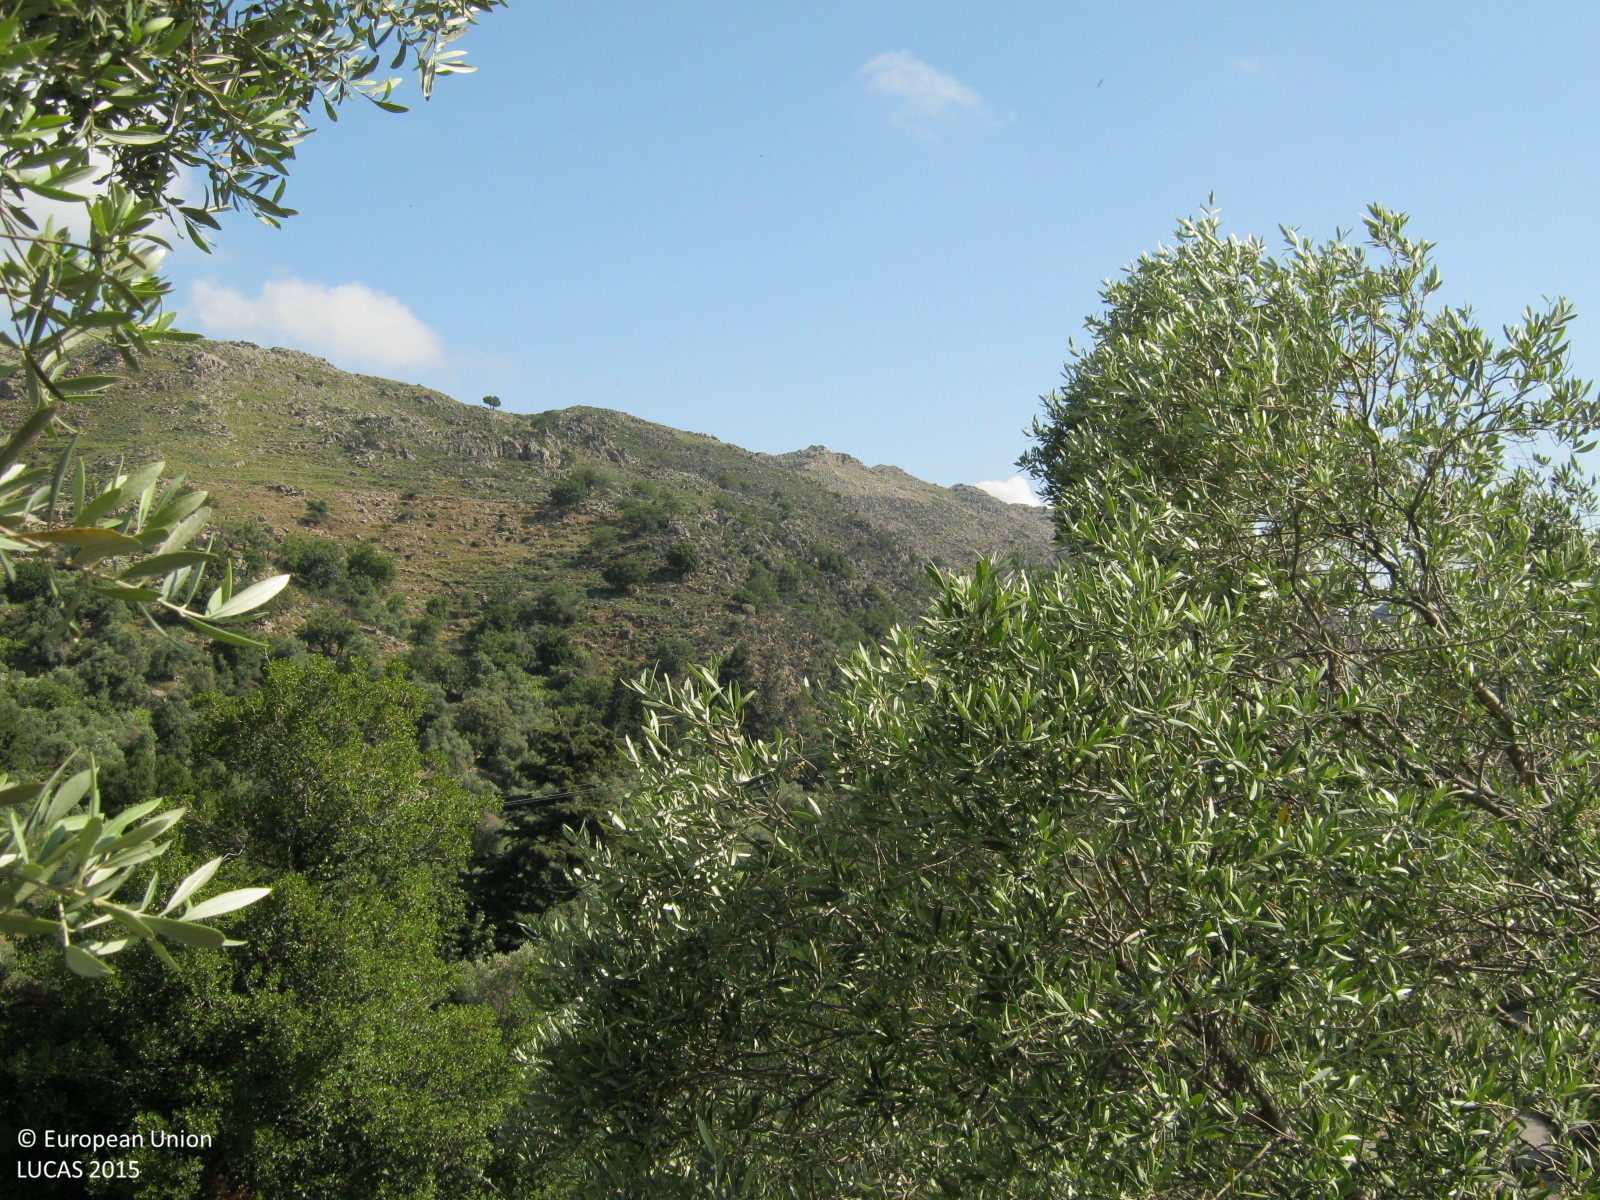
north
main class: Cropland
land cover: Olive groves
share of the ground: > 75 %
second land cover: Grassland without tree/shrub cover
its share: > 75 %
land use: Agriculture (excluding fallow land and kitchen gardens)
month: June
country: GR
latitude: 35.4037
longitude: 23.9788
